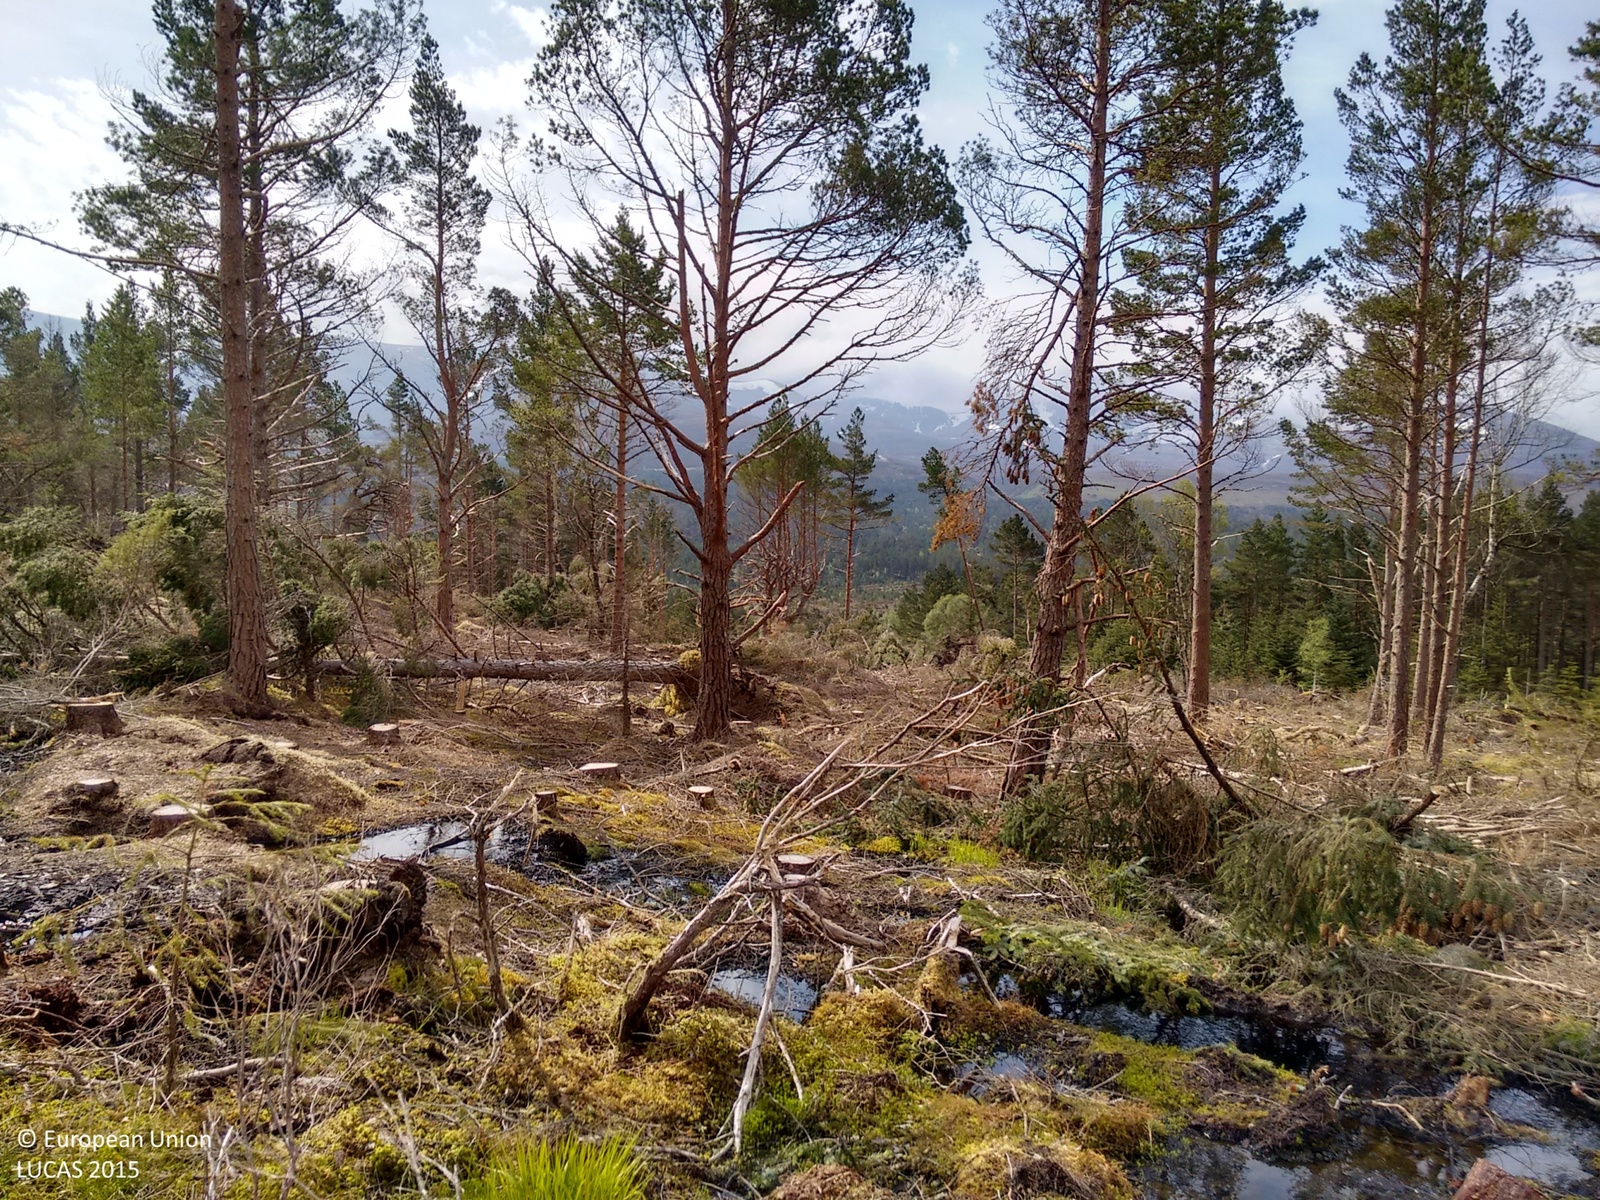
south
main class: Woodland
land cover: Pine dominated coniferous woodland
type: hemiboreal forest and nemoral coniferous forest and mixed broadleaved-coniferous forest
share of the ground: 25 - 50 %
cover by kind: lichens and mosses 50 %, coniferous forest trees 30 %
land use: Forestry
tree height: > 5 m
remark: Clear cut
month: June
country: GB
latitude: 57.1675
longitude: -3.6856
